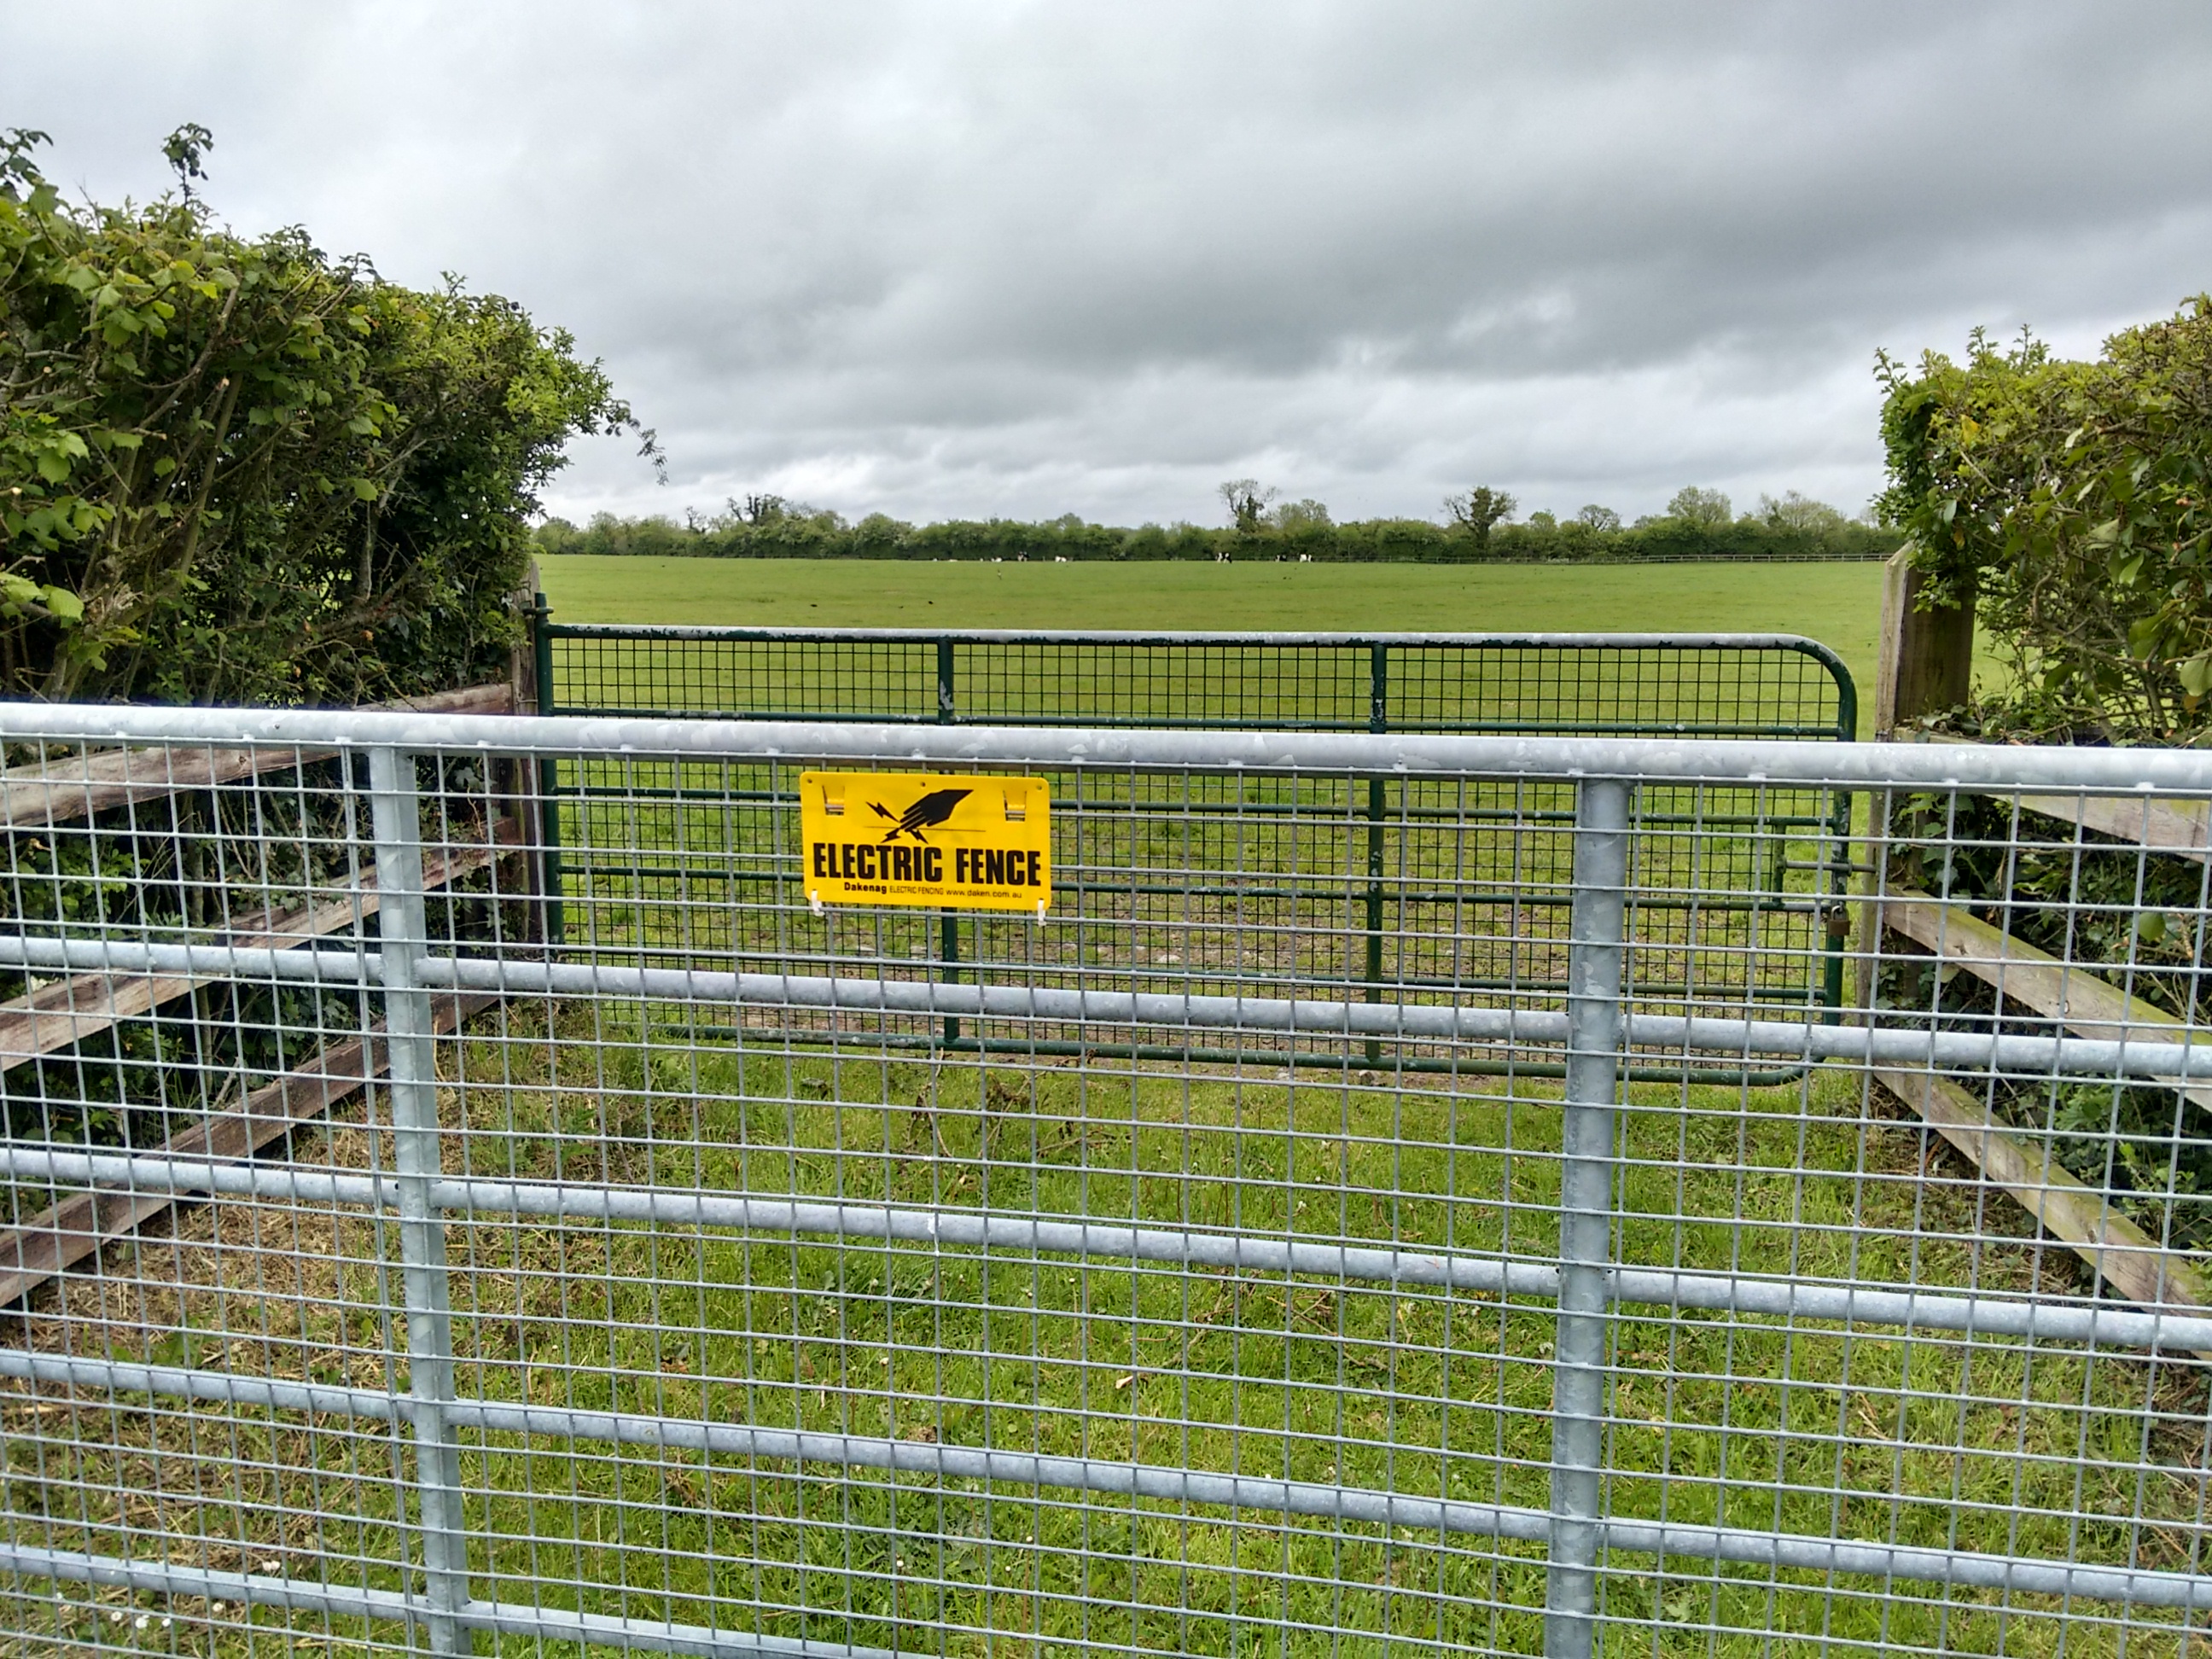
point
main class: Grassland
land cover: Grassland without tree/shrub cover
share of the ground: > 75 %
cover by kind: herbaceous plants 95 %, consolidated bare surface 5 %
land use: Agriculture (excluding fallow land and kitchen gardens)
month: May
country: IE
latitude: 53.4281
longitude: -6.5477
